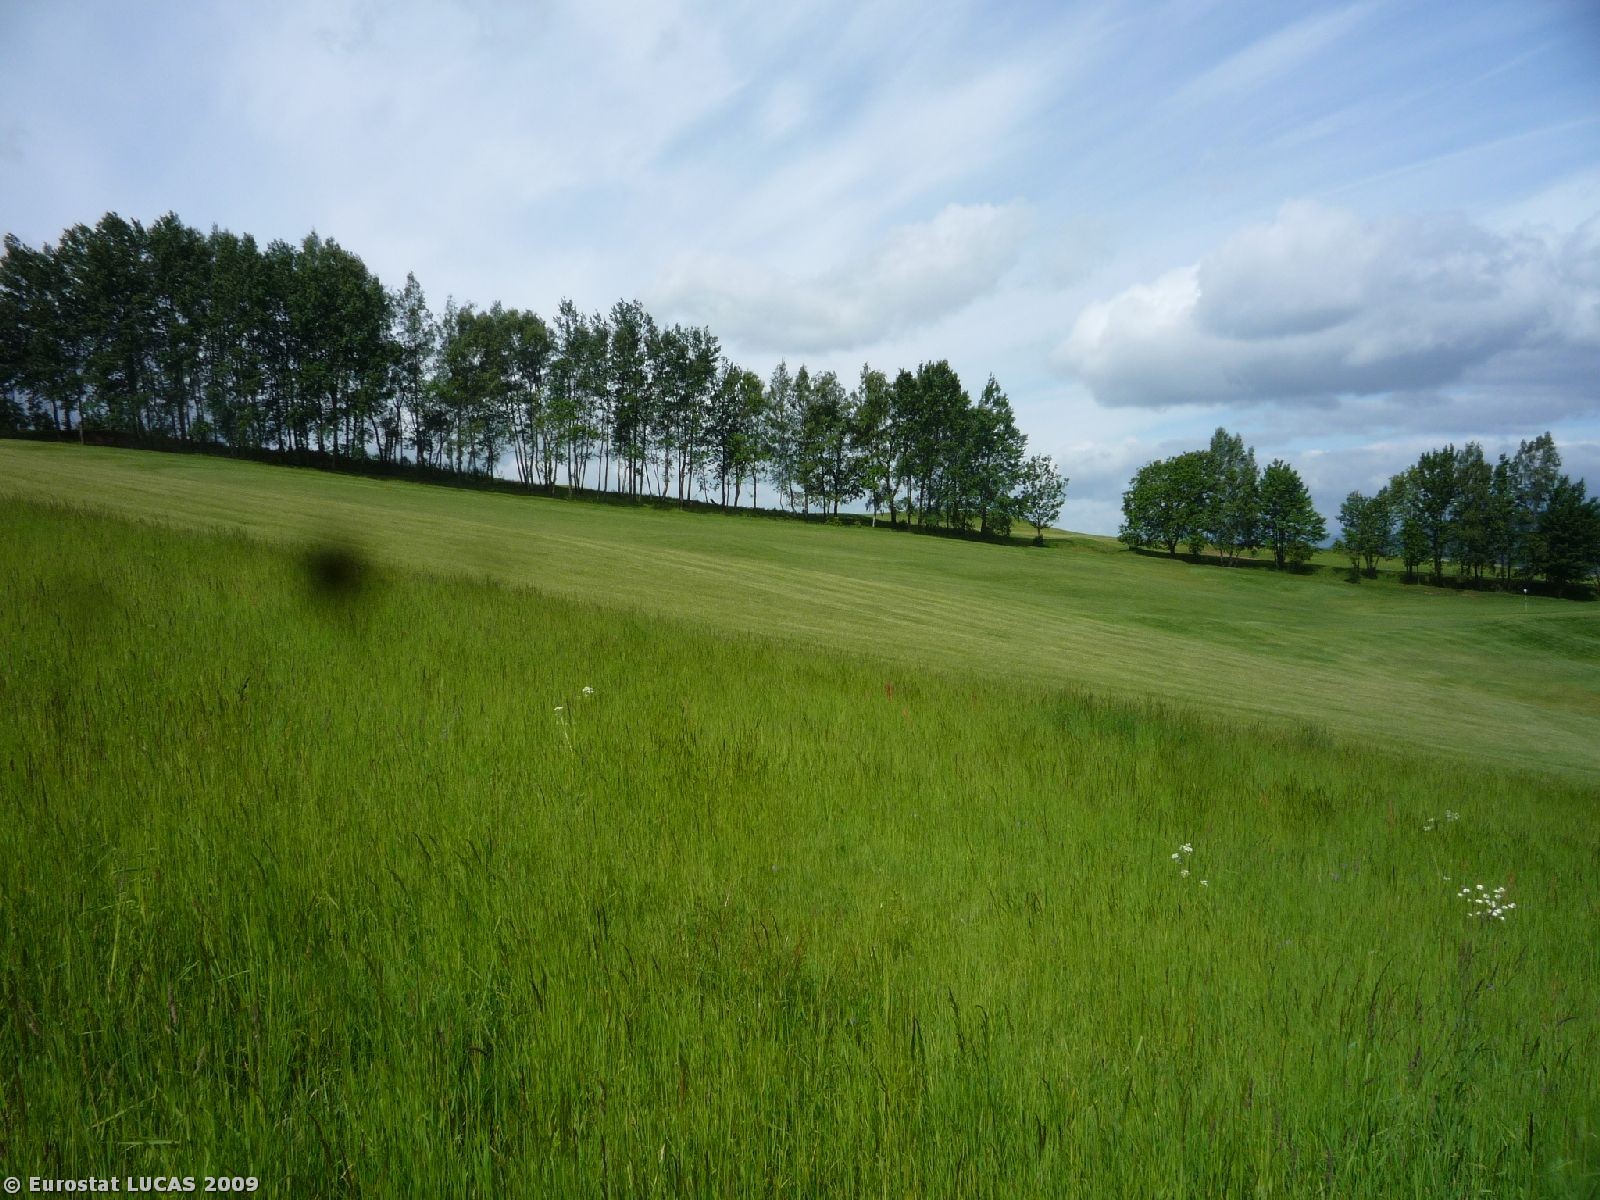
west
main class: Grassland
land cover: Grassland without tree/shrub cover
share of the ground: > 75 %
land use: Sport
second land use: Amenities, museums, leisure
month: June
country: CZ
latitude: 50.5935
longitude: 15.8394
